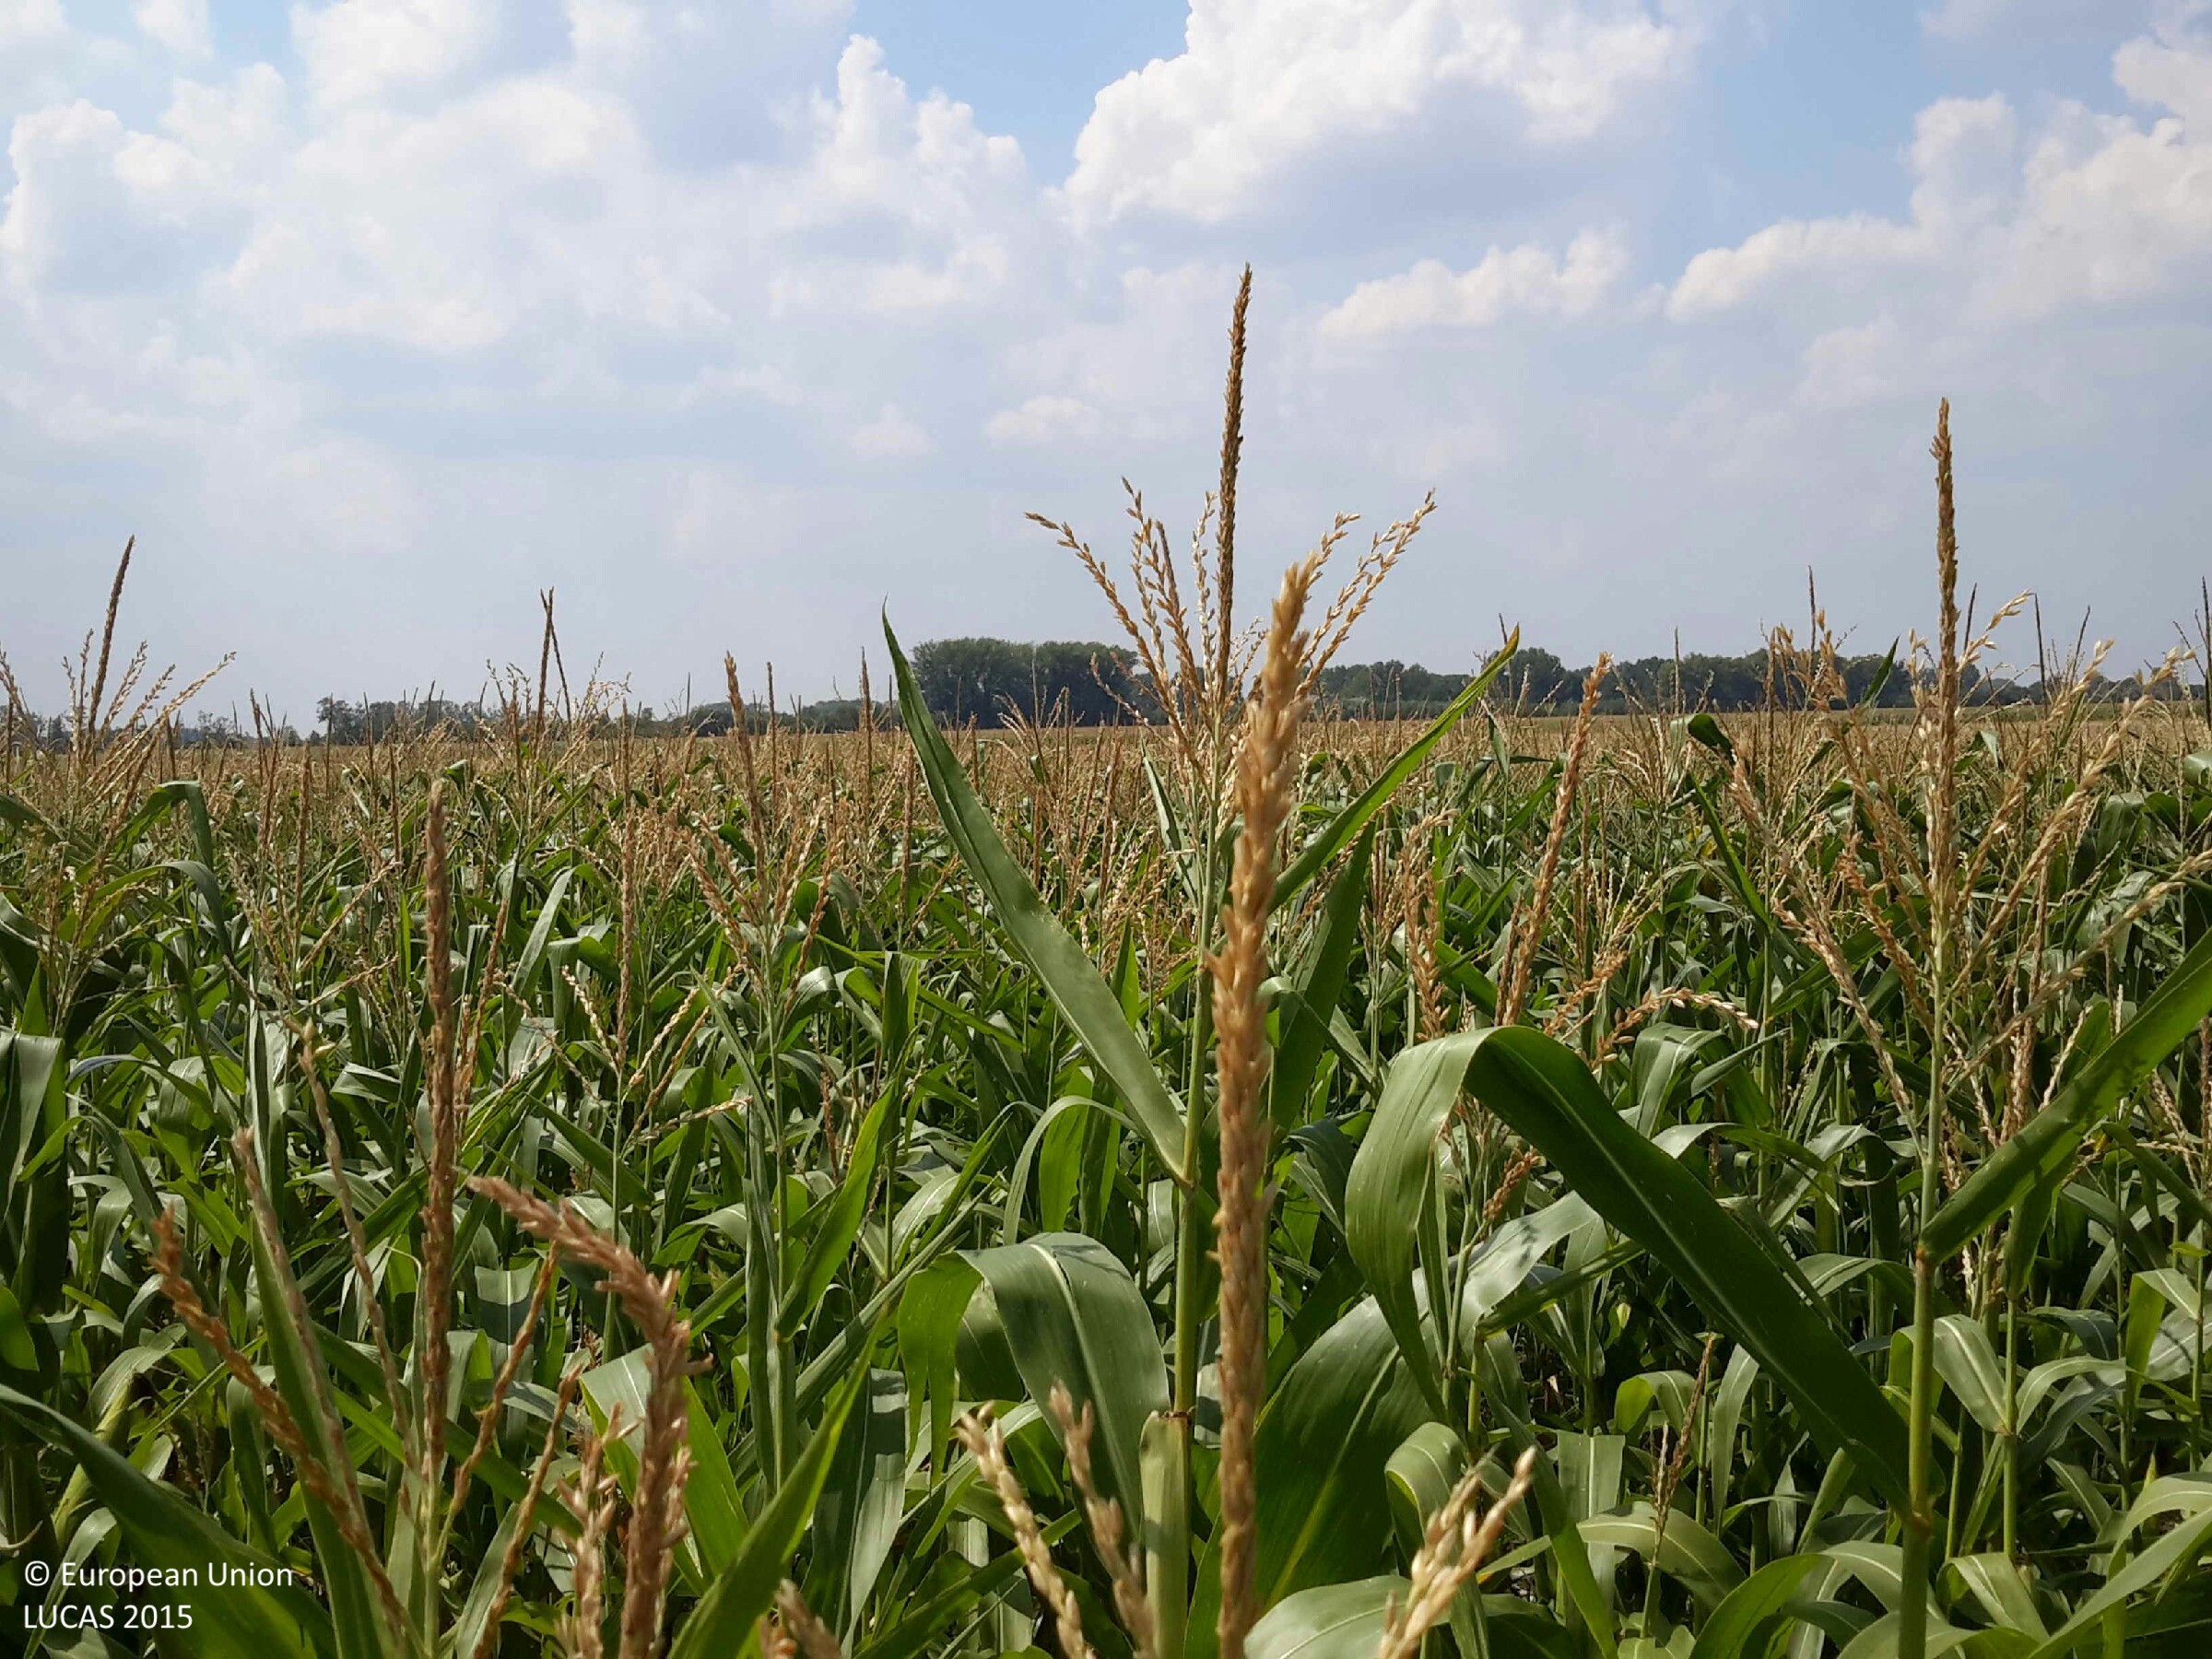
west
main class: Cropland
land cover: Maize
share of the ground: > 75 %
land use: Agriculture (excluding fallow land and kitchen gardens)
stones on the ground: < 10 %
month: August
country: HU
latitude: 47.5816
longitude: 17.3334
